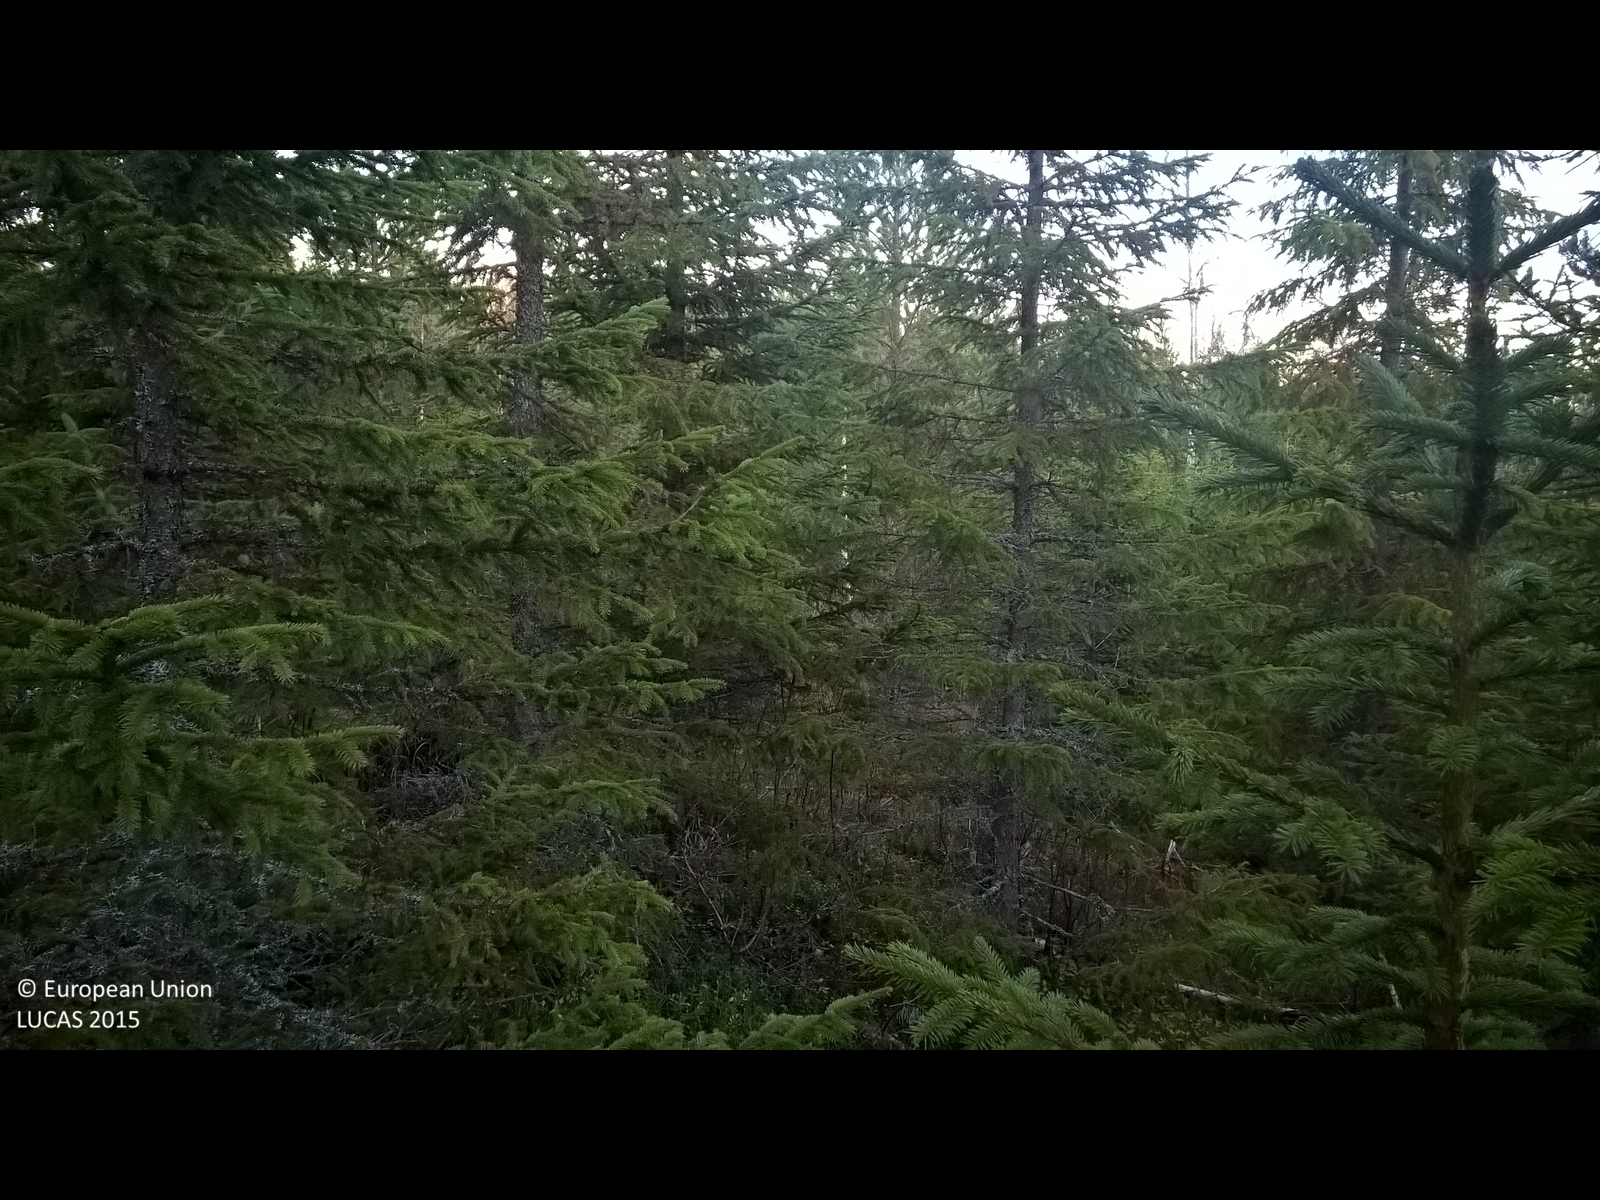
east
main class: Woodland
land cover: Spruce dominated coniferous woodland
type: boreal forest
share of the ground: 50 - 75 %
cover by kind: coniferous forest trees 70 %, lichens and mosses 30 %
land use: Forestry
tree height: > 5 m
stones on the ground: < 10 %
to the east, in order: Spruce dominated coniferous woodland; Broadleaved woodland
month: October
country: SE
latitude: 62.9575
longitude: 15.6751
